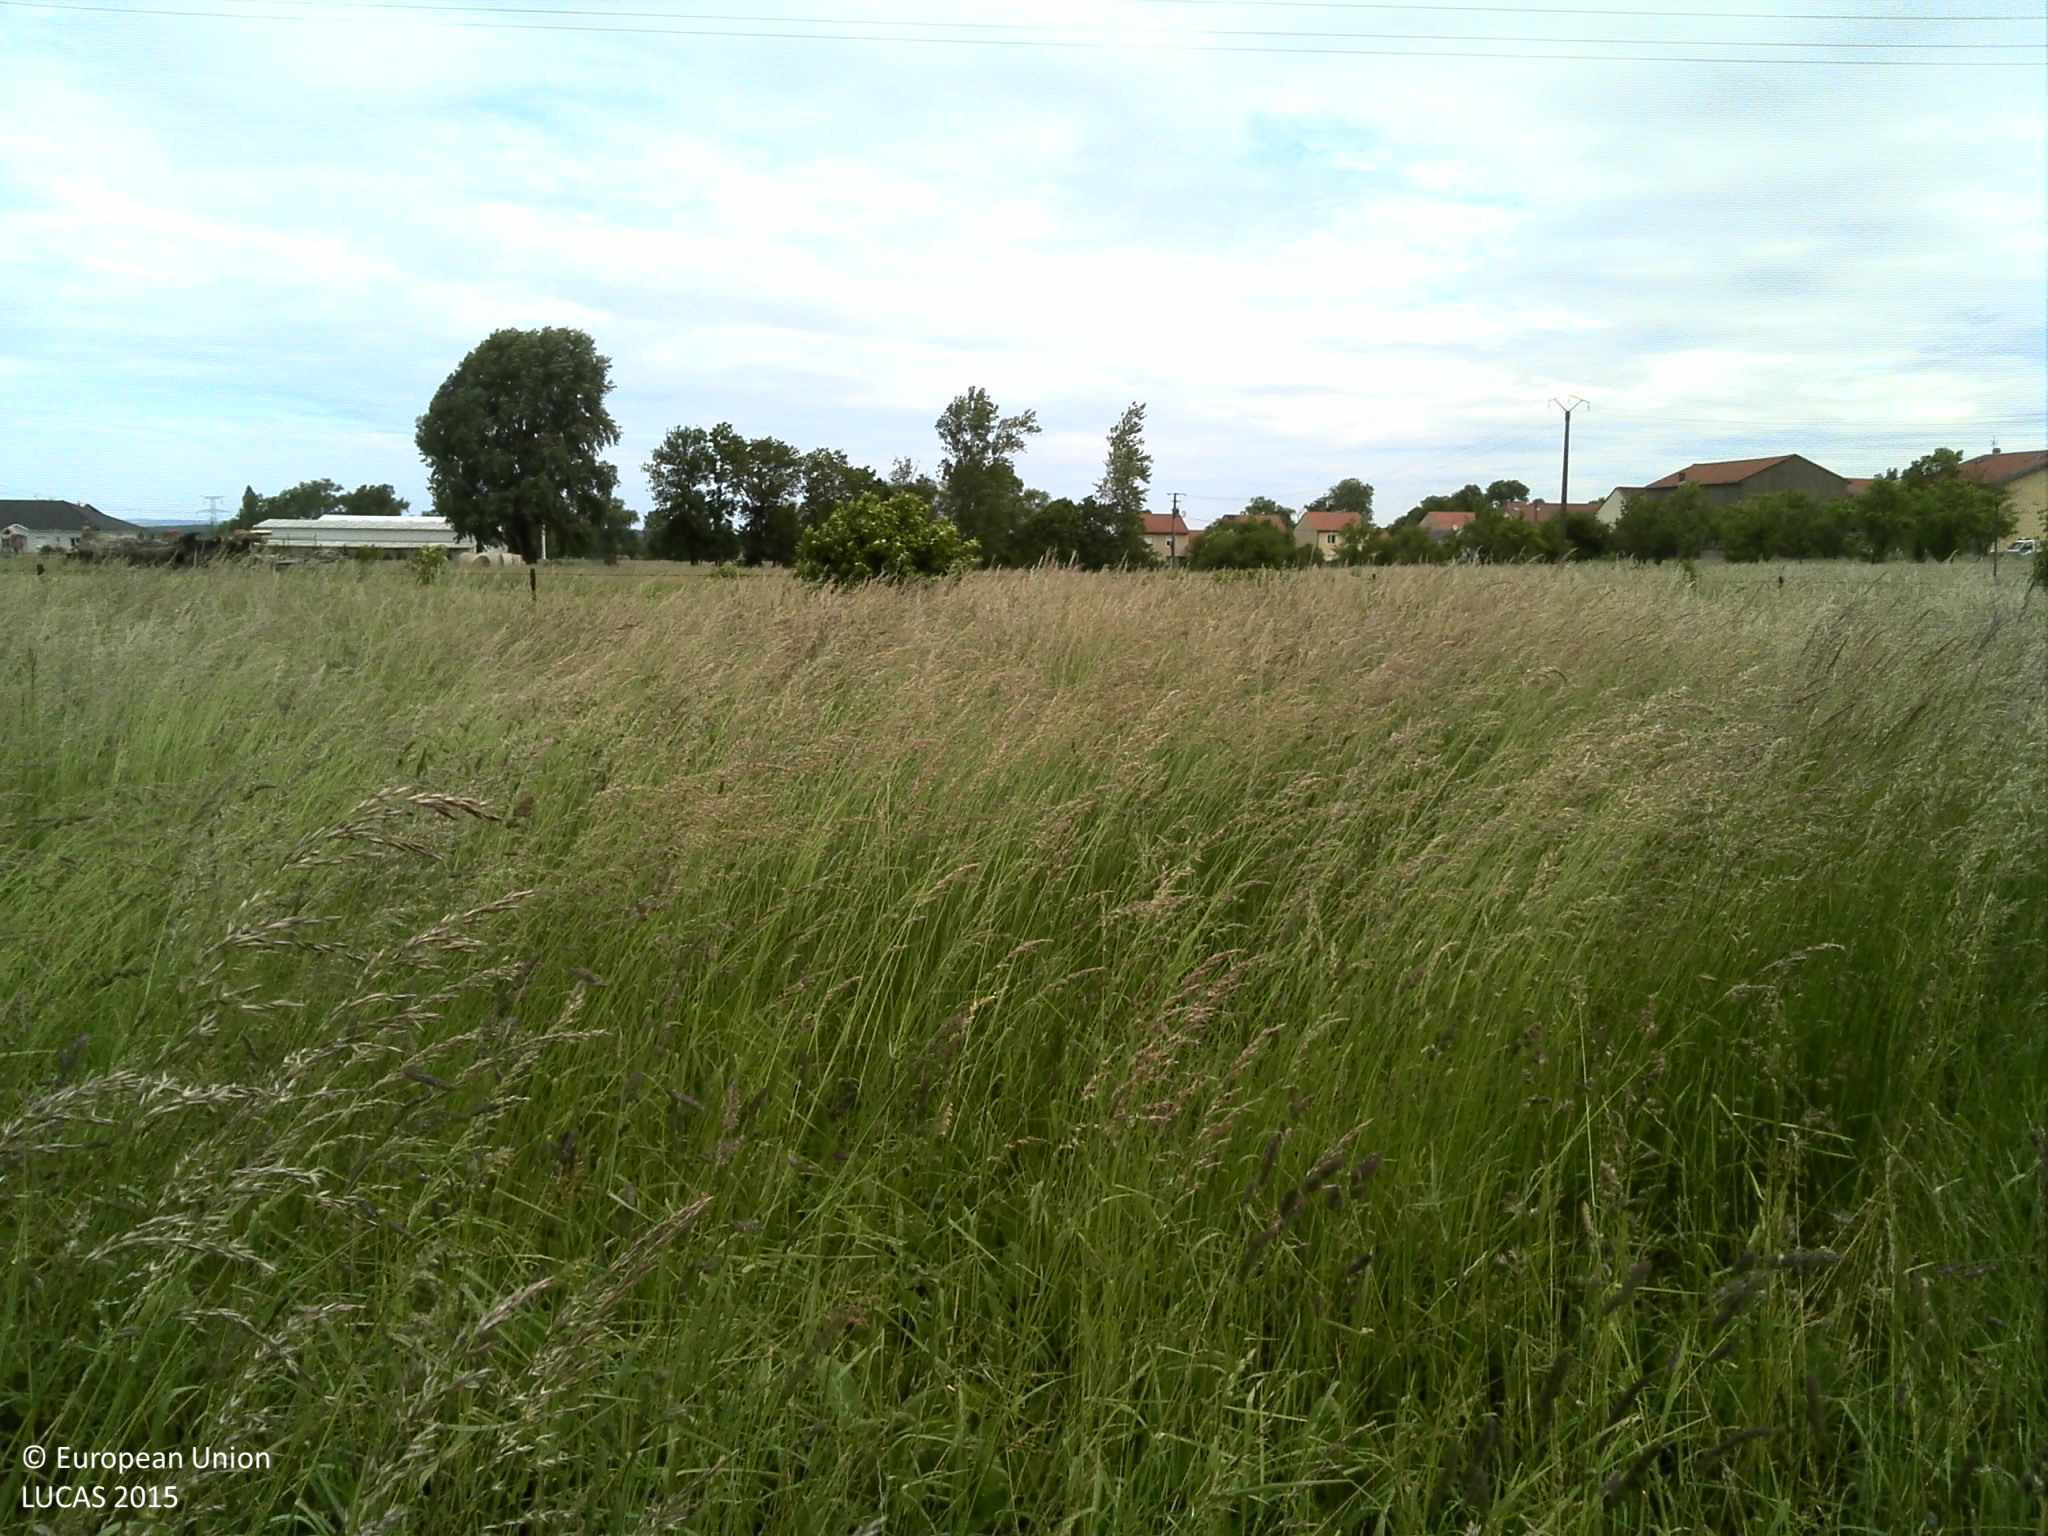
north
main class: Grassland
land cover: Grassland without tree/shrub cover
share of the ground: > 75 %
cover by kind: herbaceous plants 100 %
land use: Agriculture (excluding fallow land and kitchen gardens)
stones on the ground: < 10 %
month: June
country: FR
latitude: 48.9691
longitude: 6.2159
